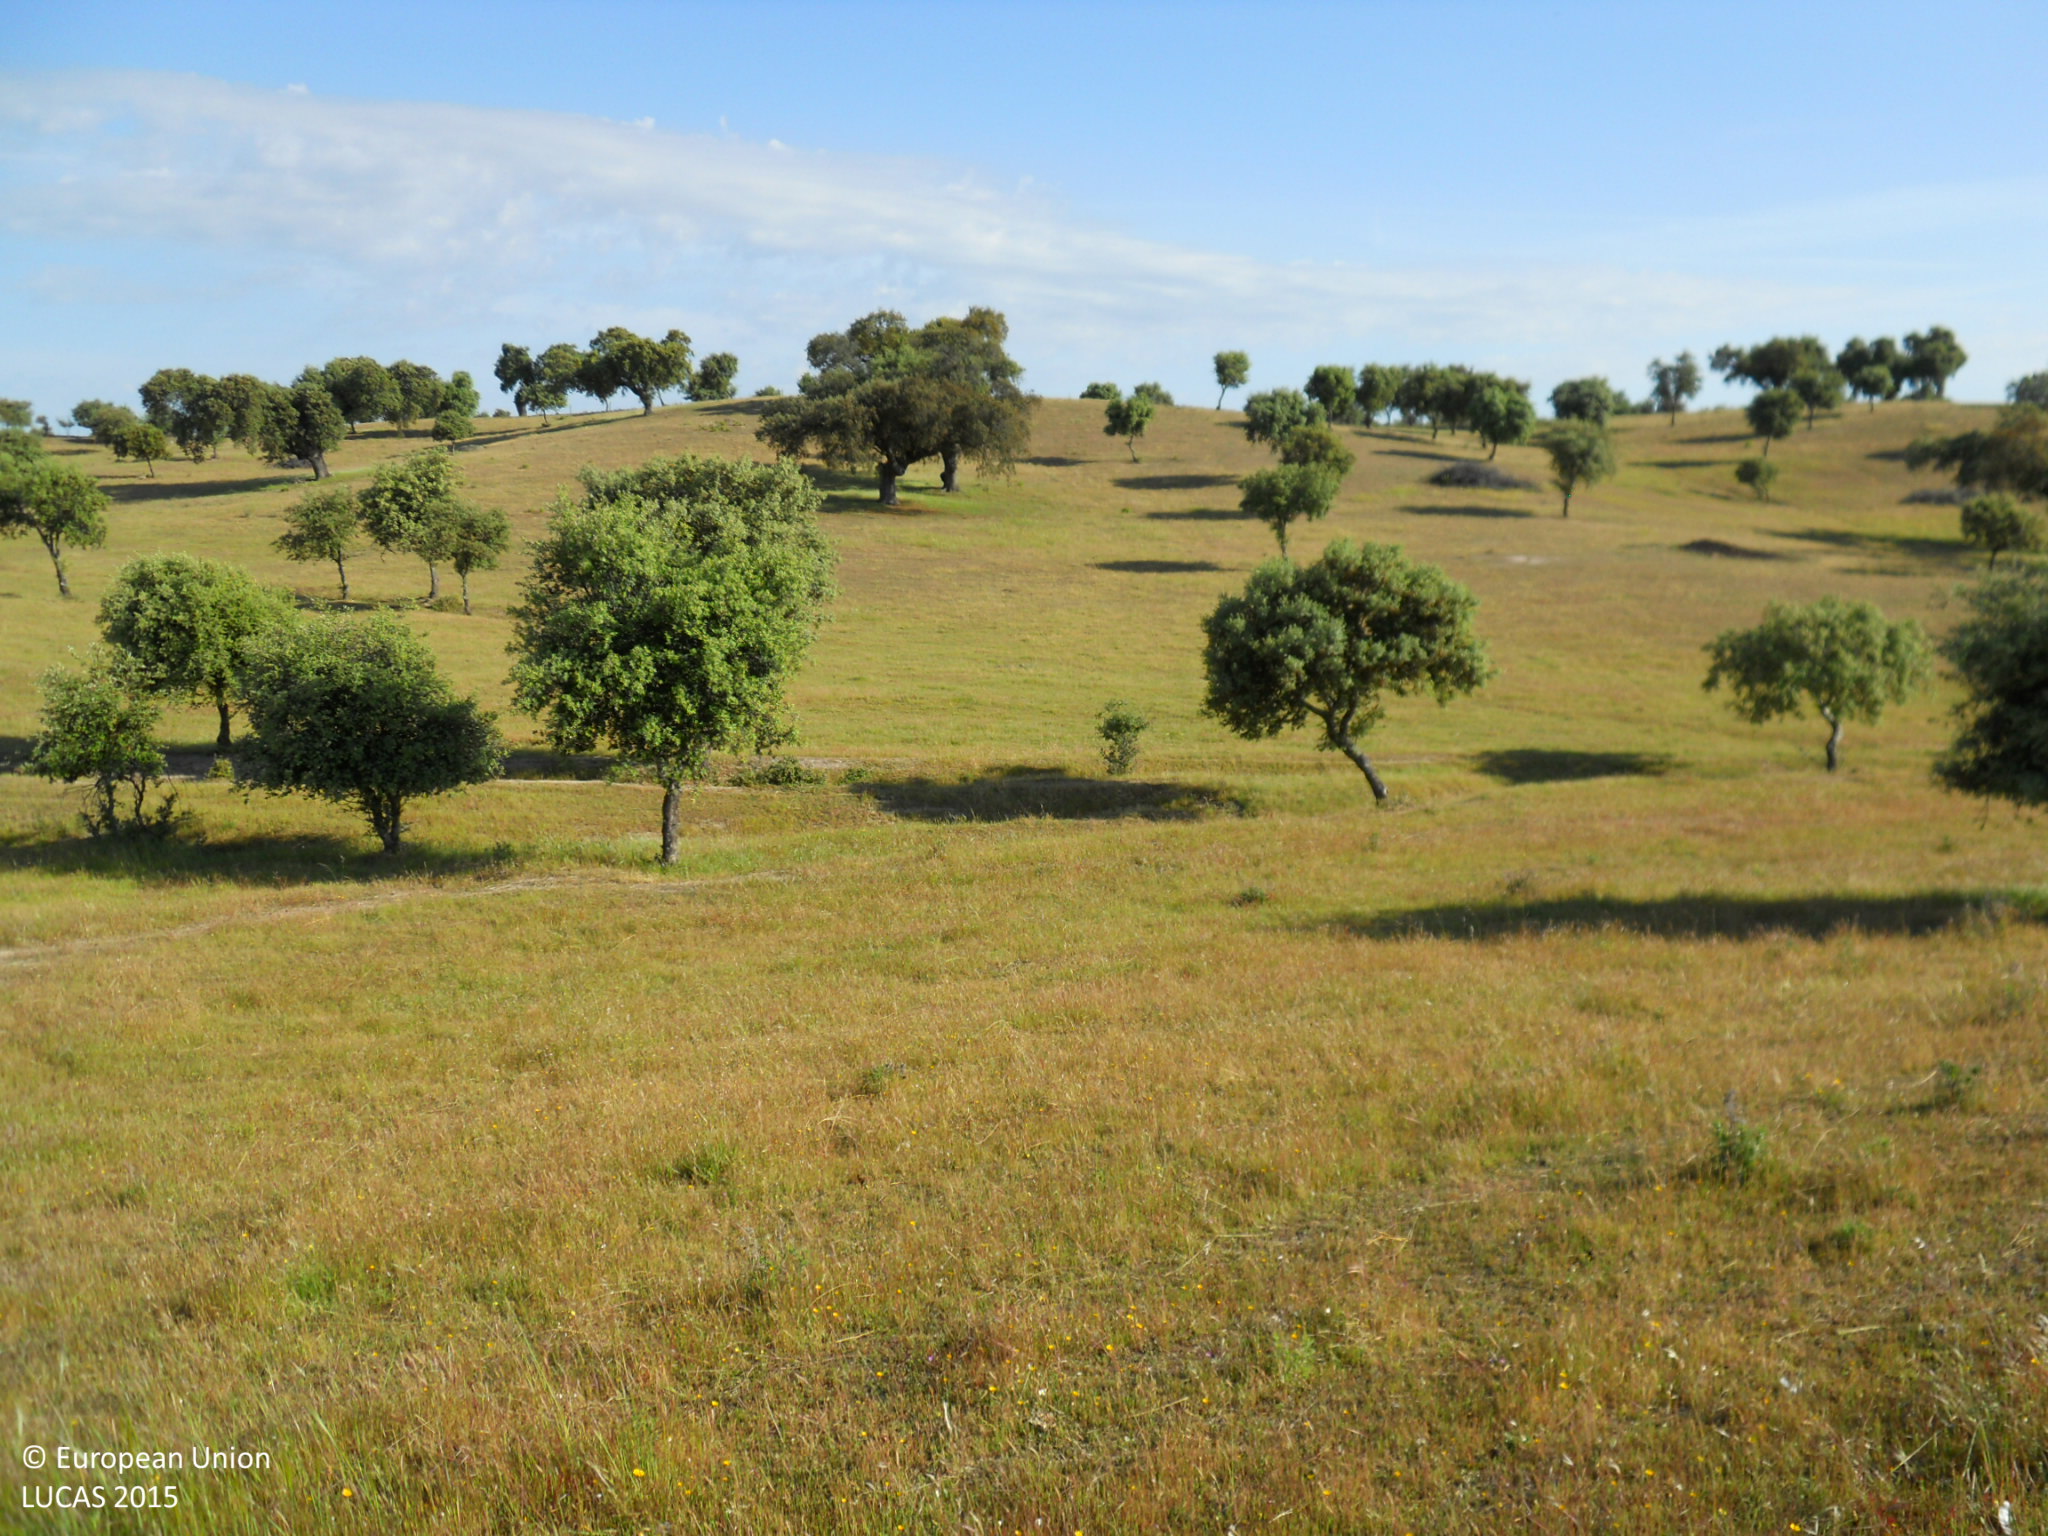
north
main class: Grassland
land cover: Grassland without tree/shrub cover
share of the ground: > 75 %
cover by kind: herbaceous plants 95 %, shrubs 5 %
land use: Agriculture (excluding fallow land and kitchen gardens)
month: April
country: ES
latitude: 39.2265
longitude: -6.9296
